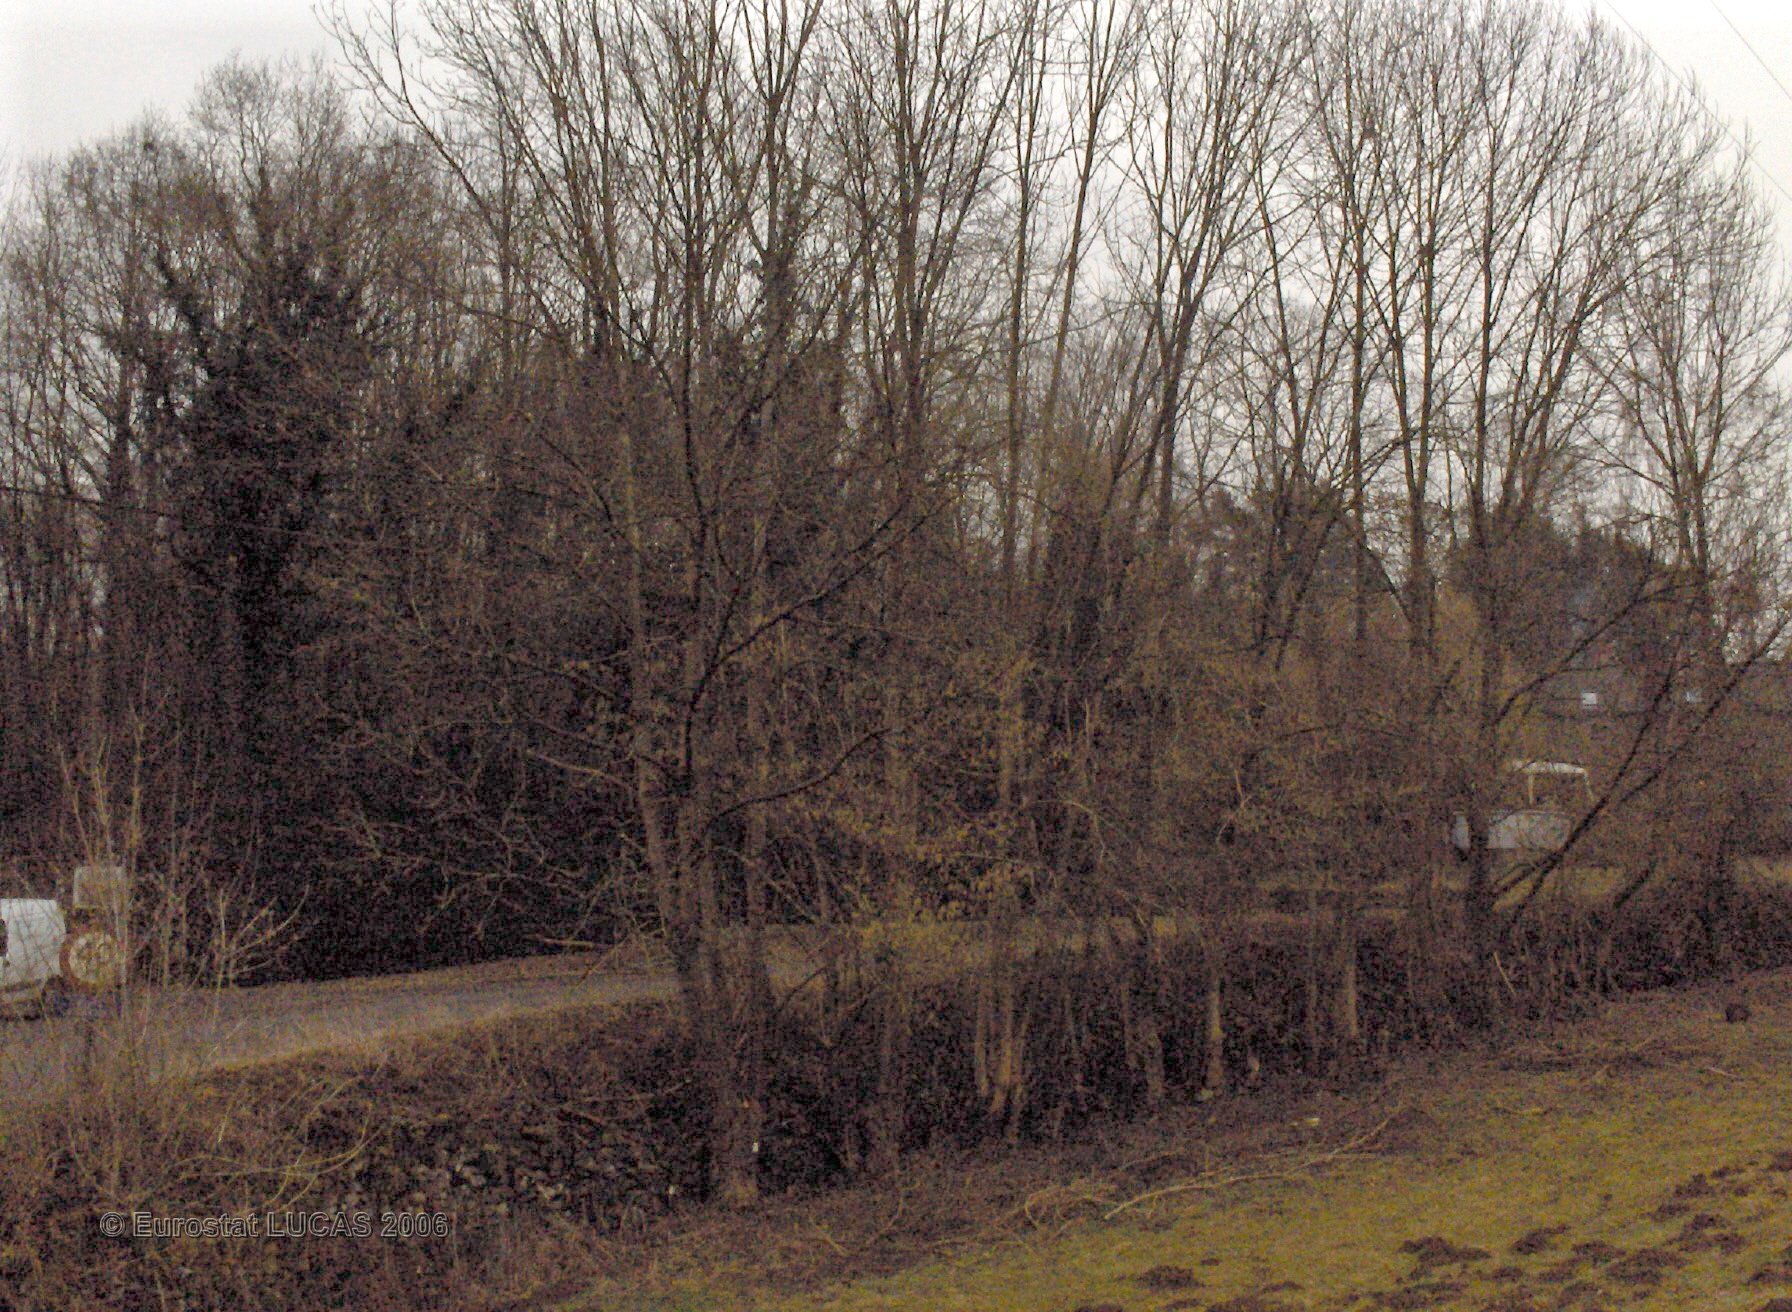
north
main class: Grassland
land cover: Grassland without tree/shrub cover
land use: Agriculture (excluding fallow land and kitchen gardens)
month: March
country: BE
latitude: 50.4636
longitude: 5.2502
